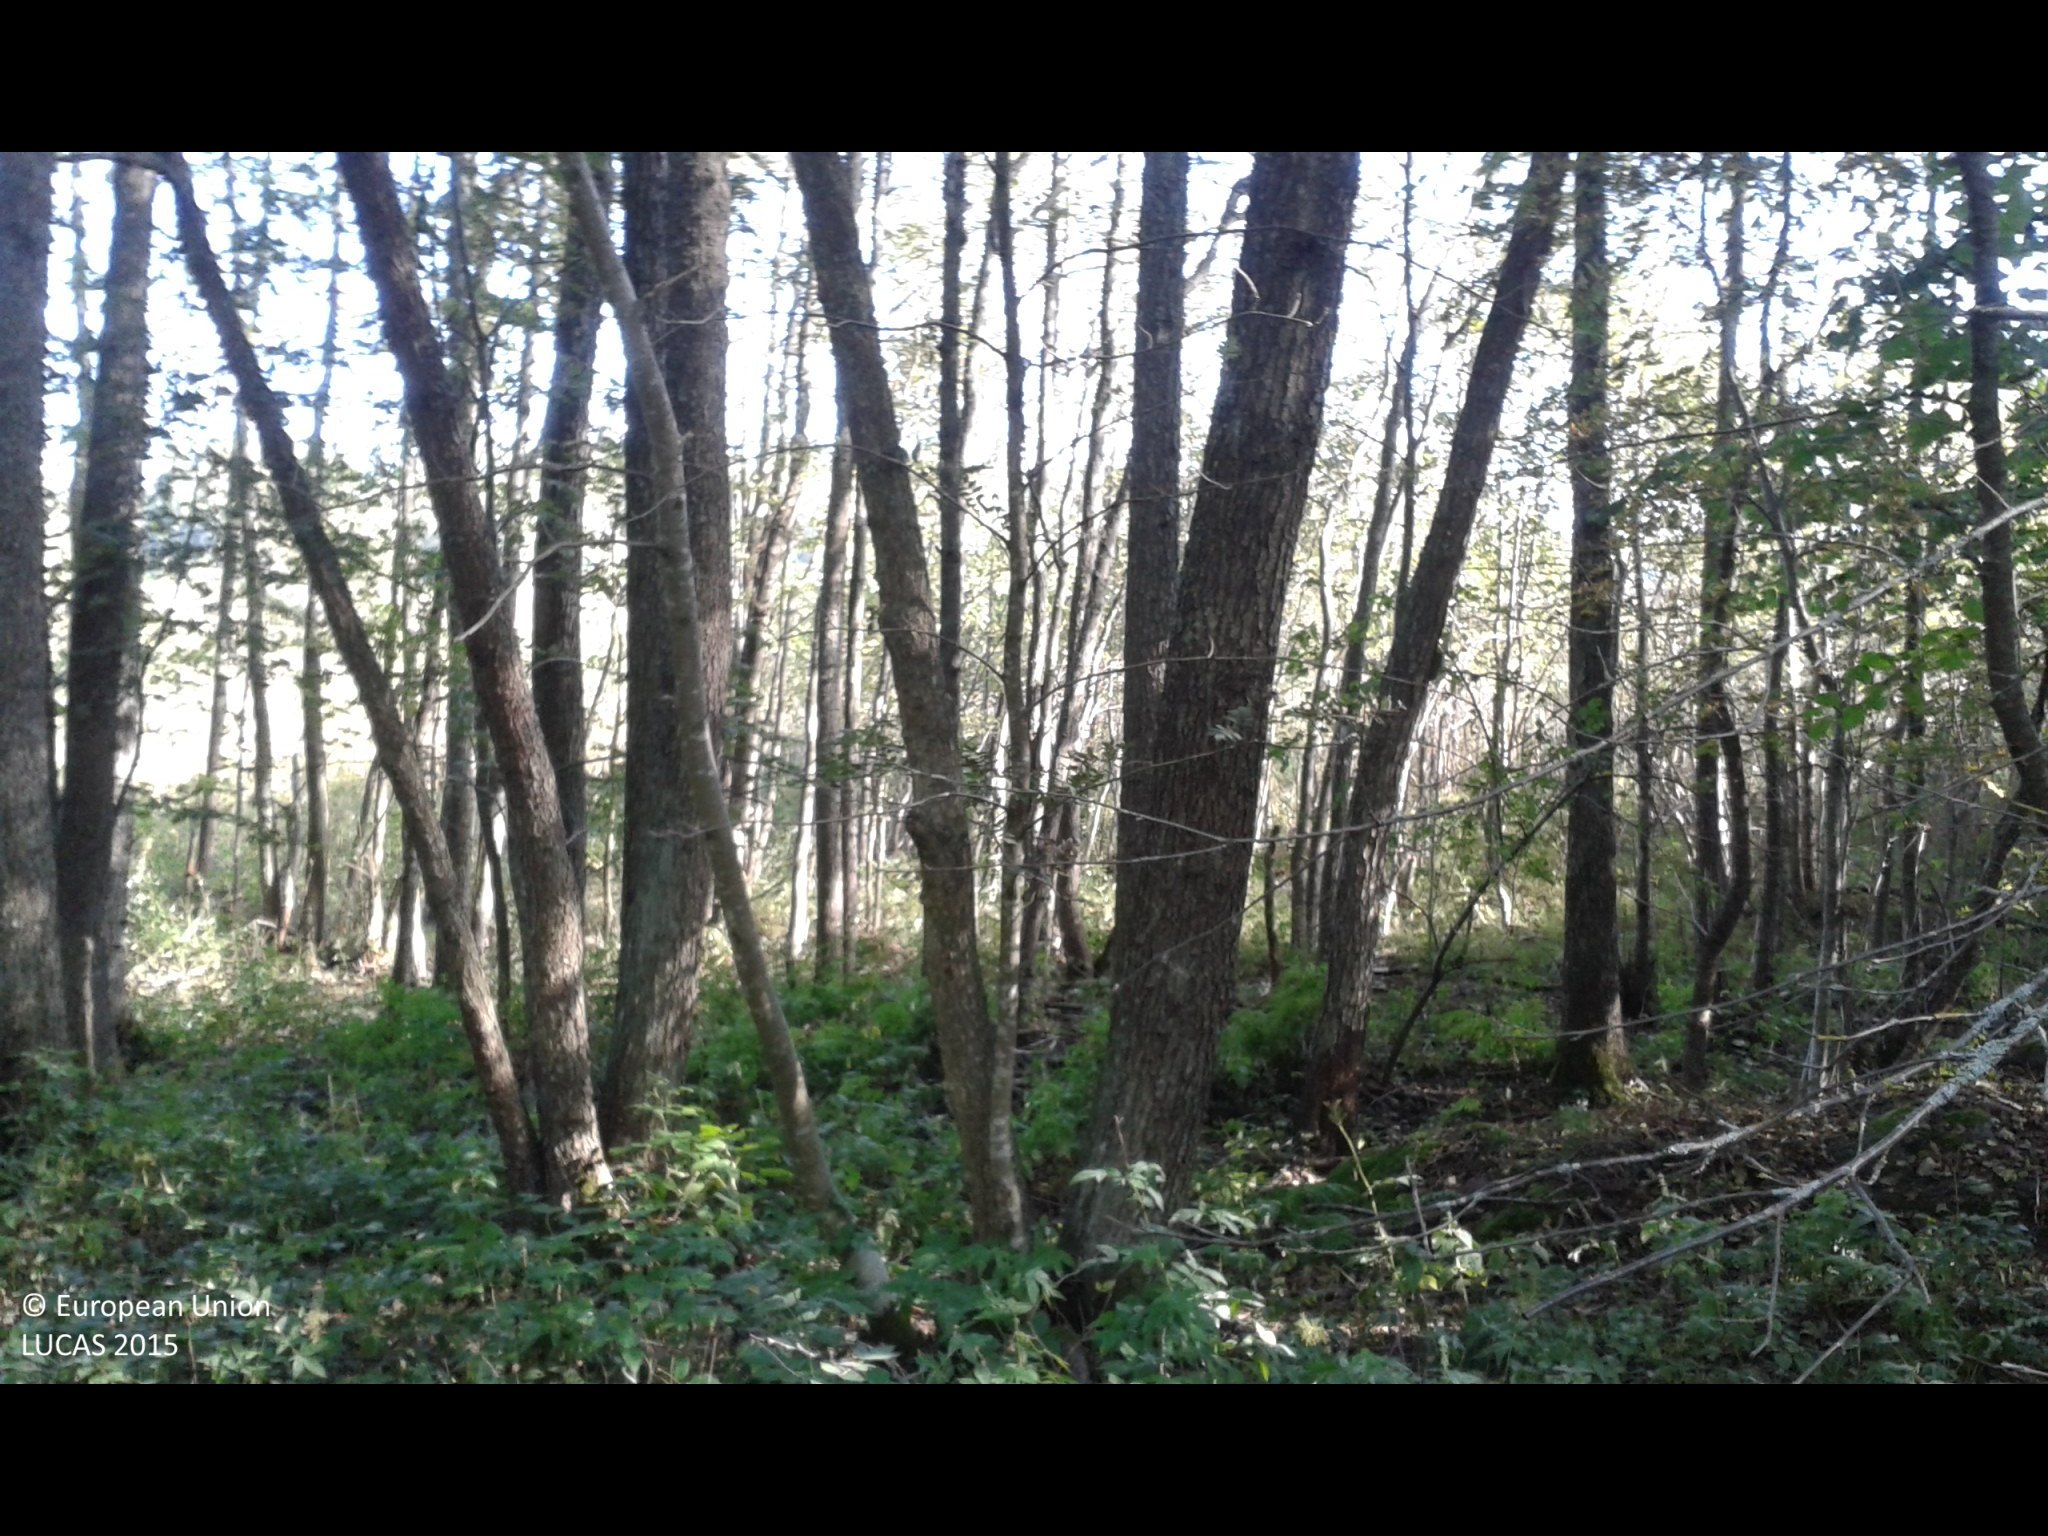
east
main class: Woodland
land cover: Broadleaved woodland
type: hemiboreal forest and nemoral coniferous forest and mixed broadleaved-coniferous forest
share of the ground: > 75 %
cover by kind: broadleaved forest trees 100 %
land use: Amenities, museums, leisure
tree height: > 5 m
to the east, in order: Broadleaved woodland; Inland marshes
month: September
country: SE
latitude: 58.9270
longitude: 17.5892
